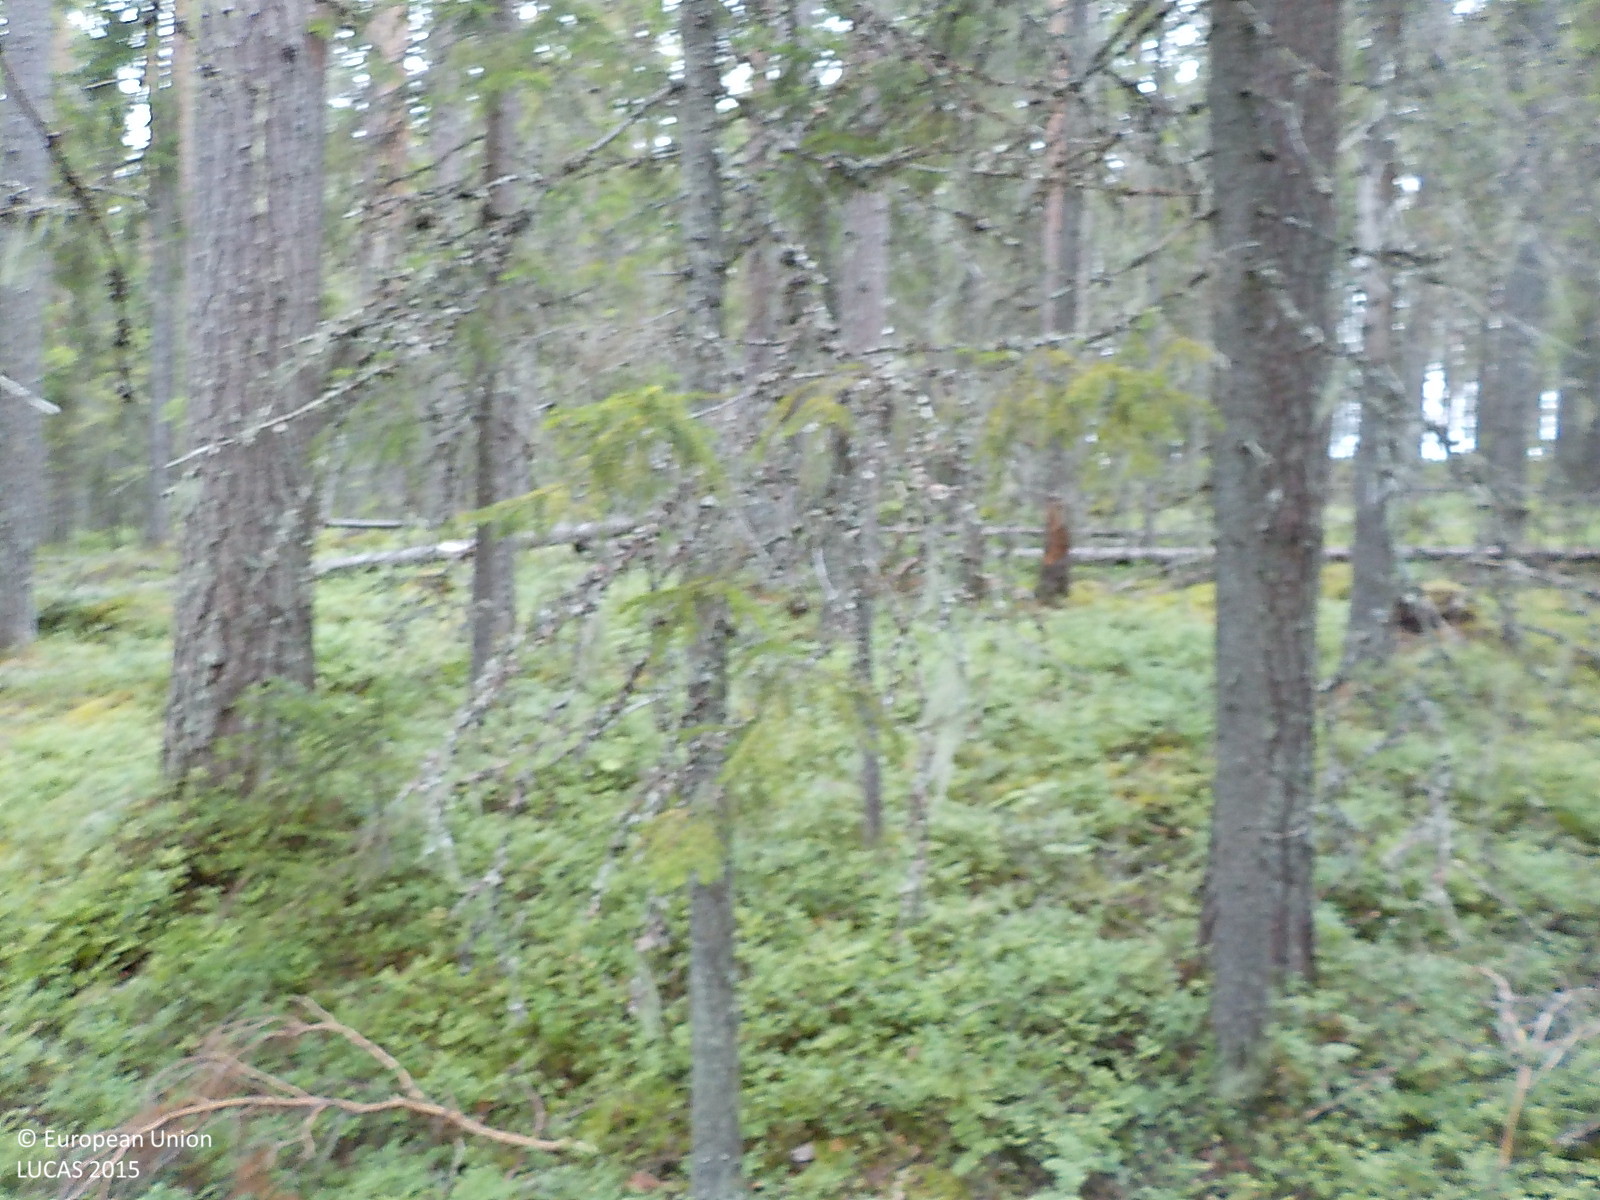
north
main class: Woodland
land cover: Spruce dominated coniferous woodland
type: boreal forest
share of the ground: > 75 %
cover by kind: coniferous forest trees 85 %, shrubs 15 %
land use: Forestry
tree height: > 5 m
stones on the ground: 10 - 25 %
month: September
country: SE
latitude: 63.2781
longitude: 17.8496
